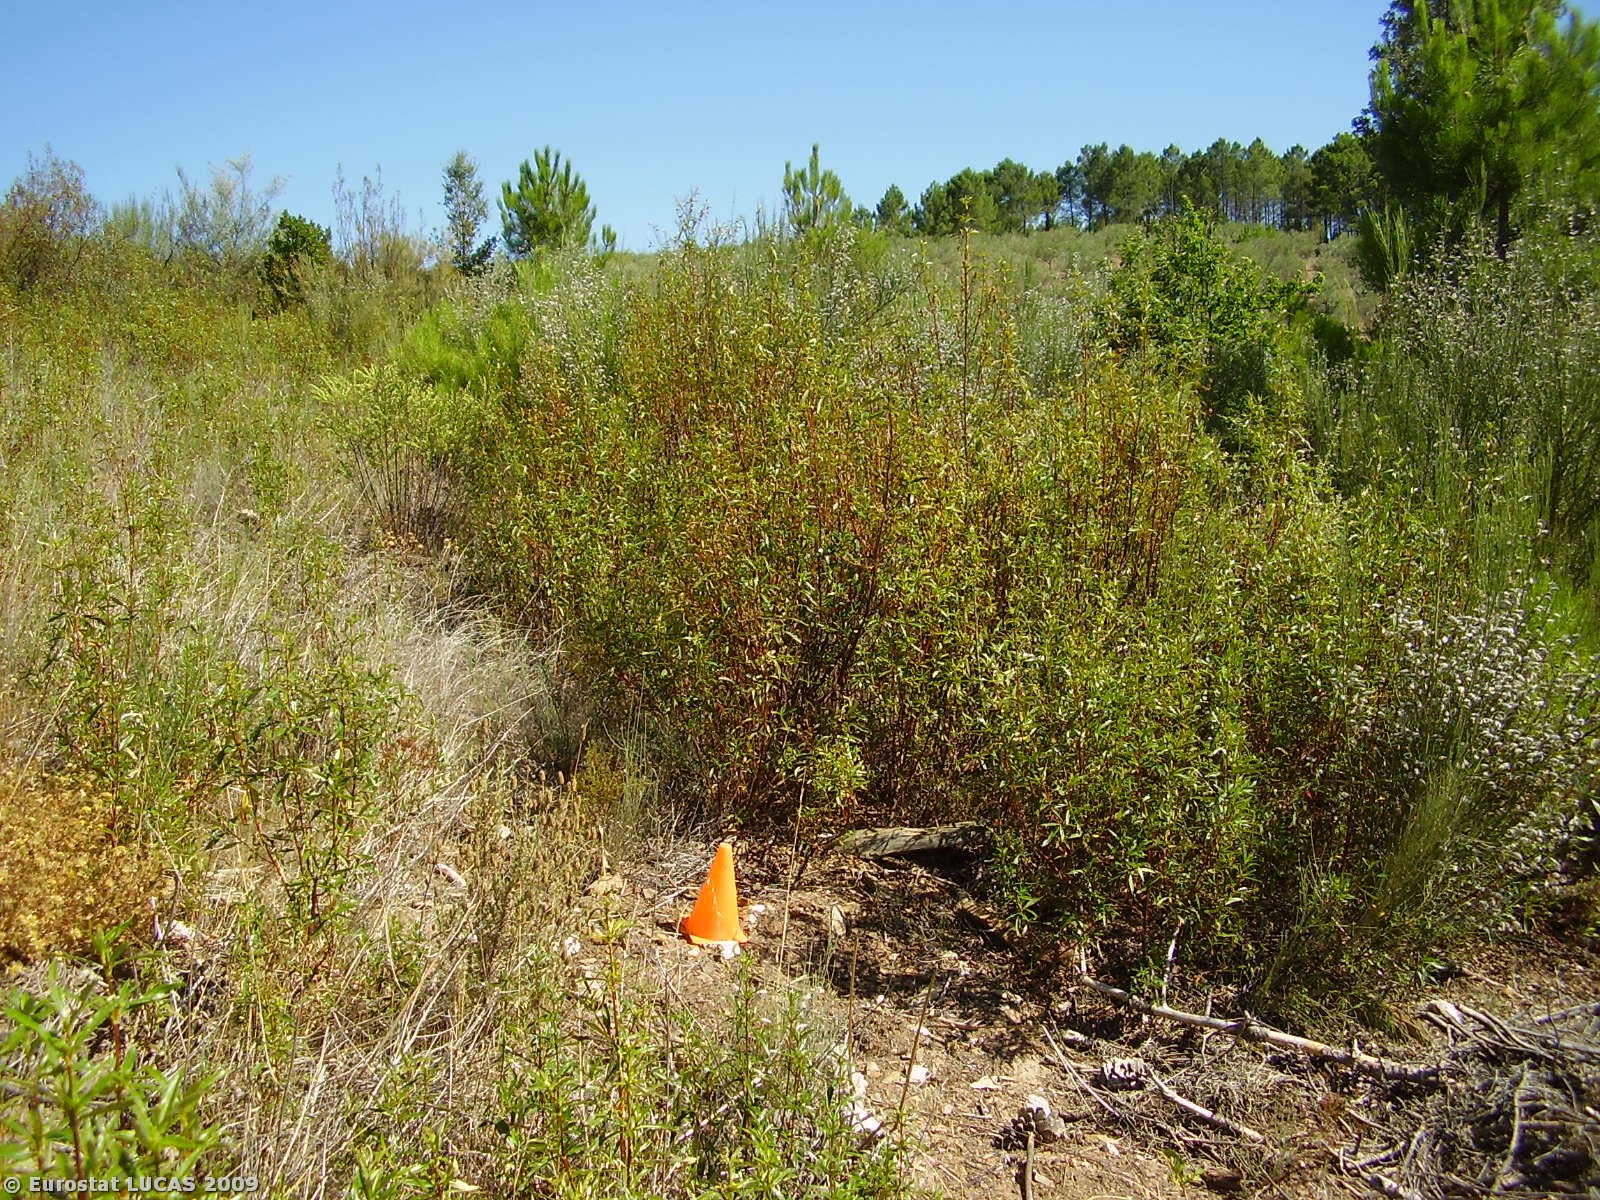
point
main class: Shrubland
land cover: Shrubland with sparse tree cover
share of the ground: > 75 %
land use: Fallow land
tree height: > 5 m
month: August
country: PT
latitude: 41.2217
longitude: -6.7934
